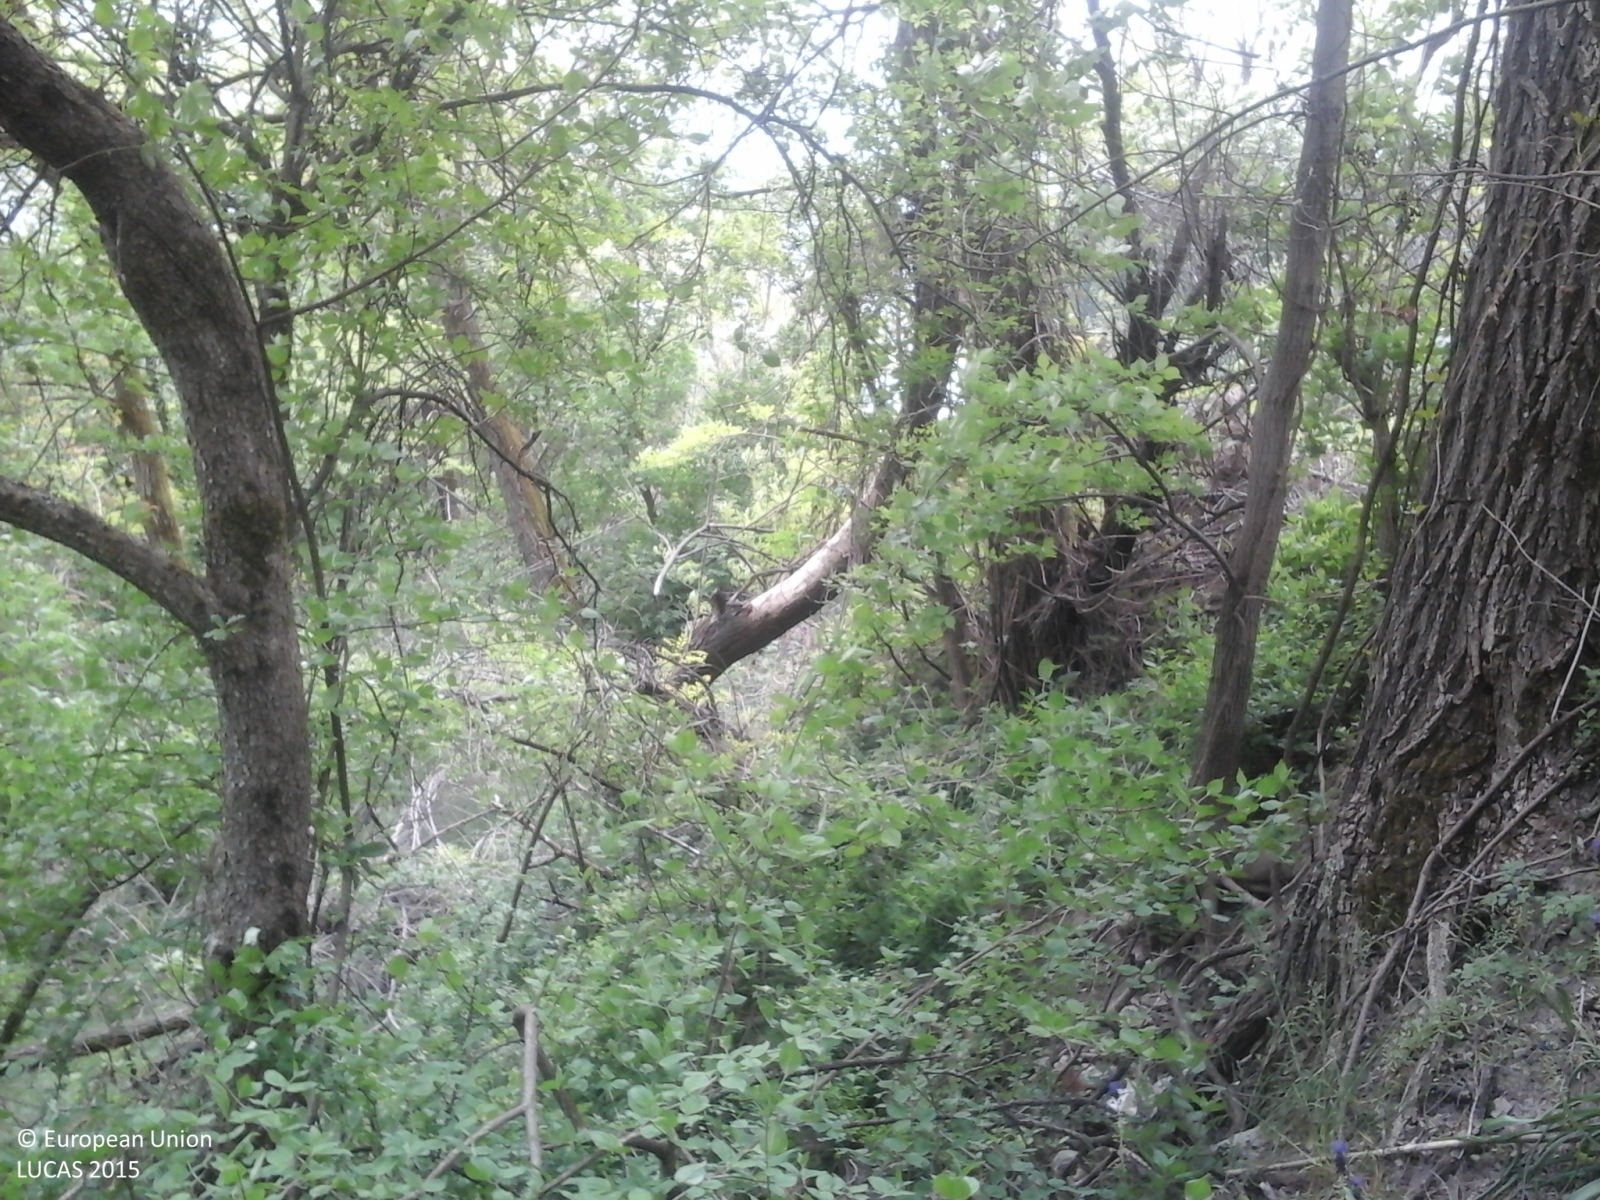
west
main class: Woodland
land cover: Broadleaved woodland
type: thermophilous deciduous forest
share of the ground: > 75 %
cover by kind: broadleaved forest trees 100 %
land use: Forestry
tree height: > 5 m
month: April
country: IT
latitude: 46.2737
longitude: 11.0756
